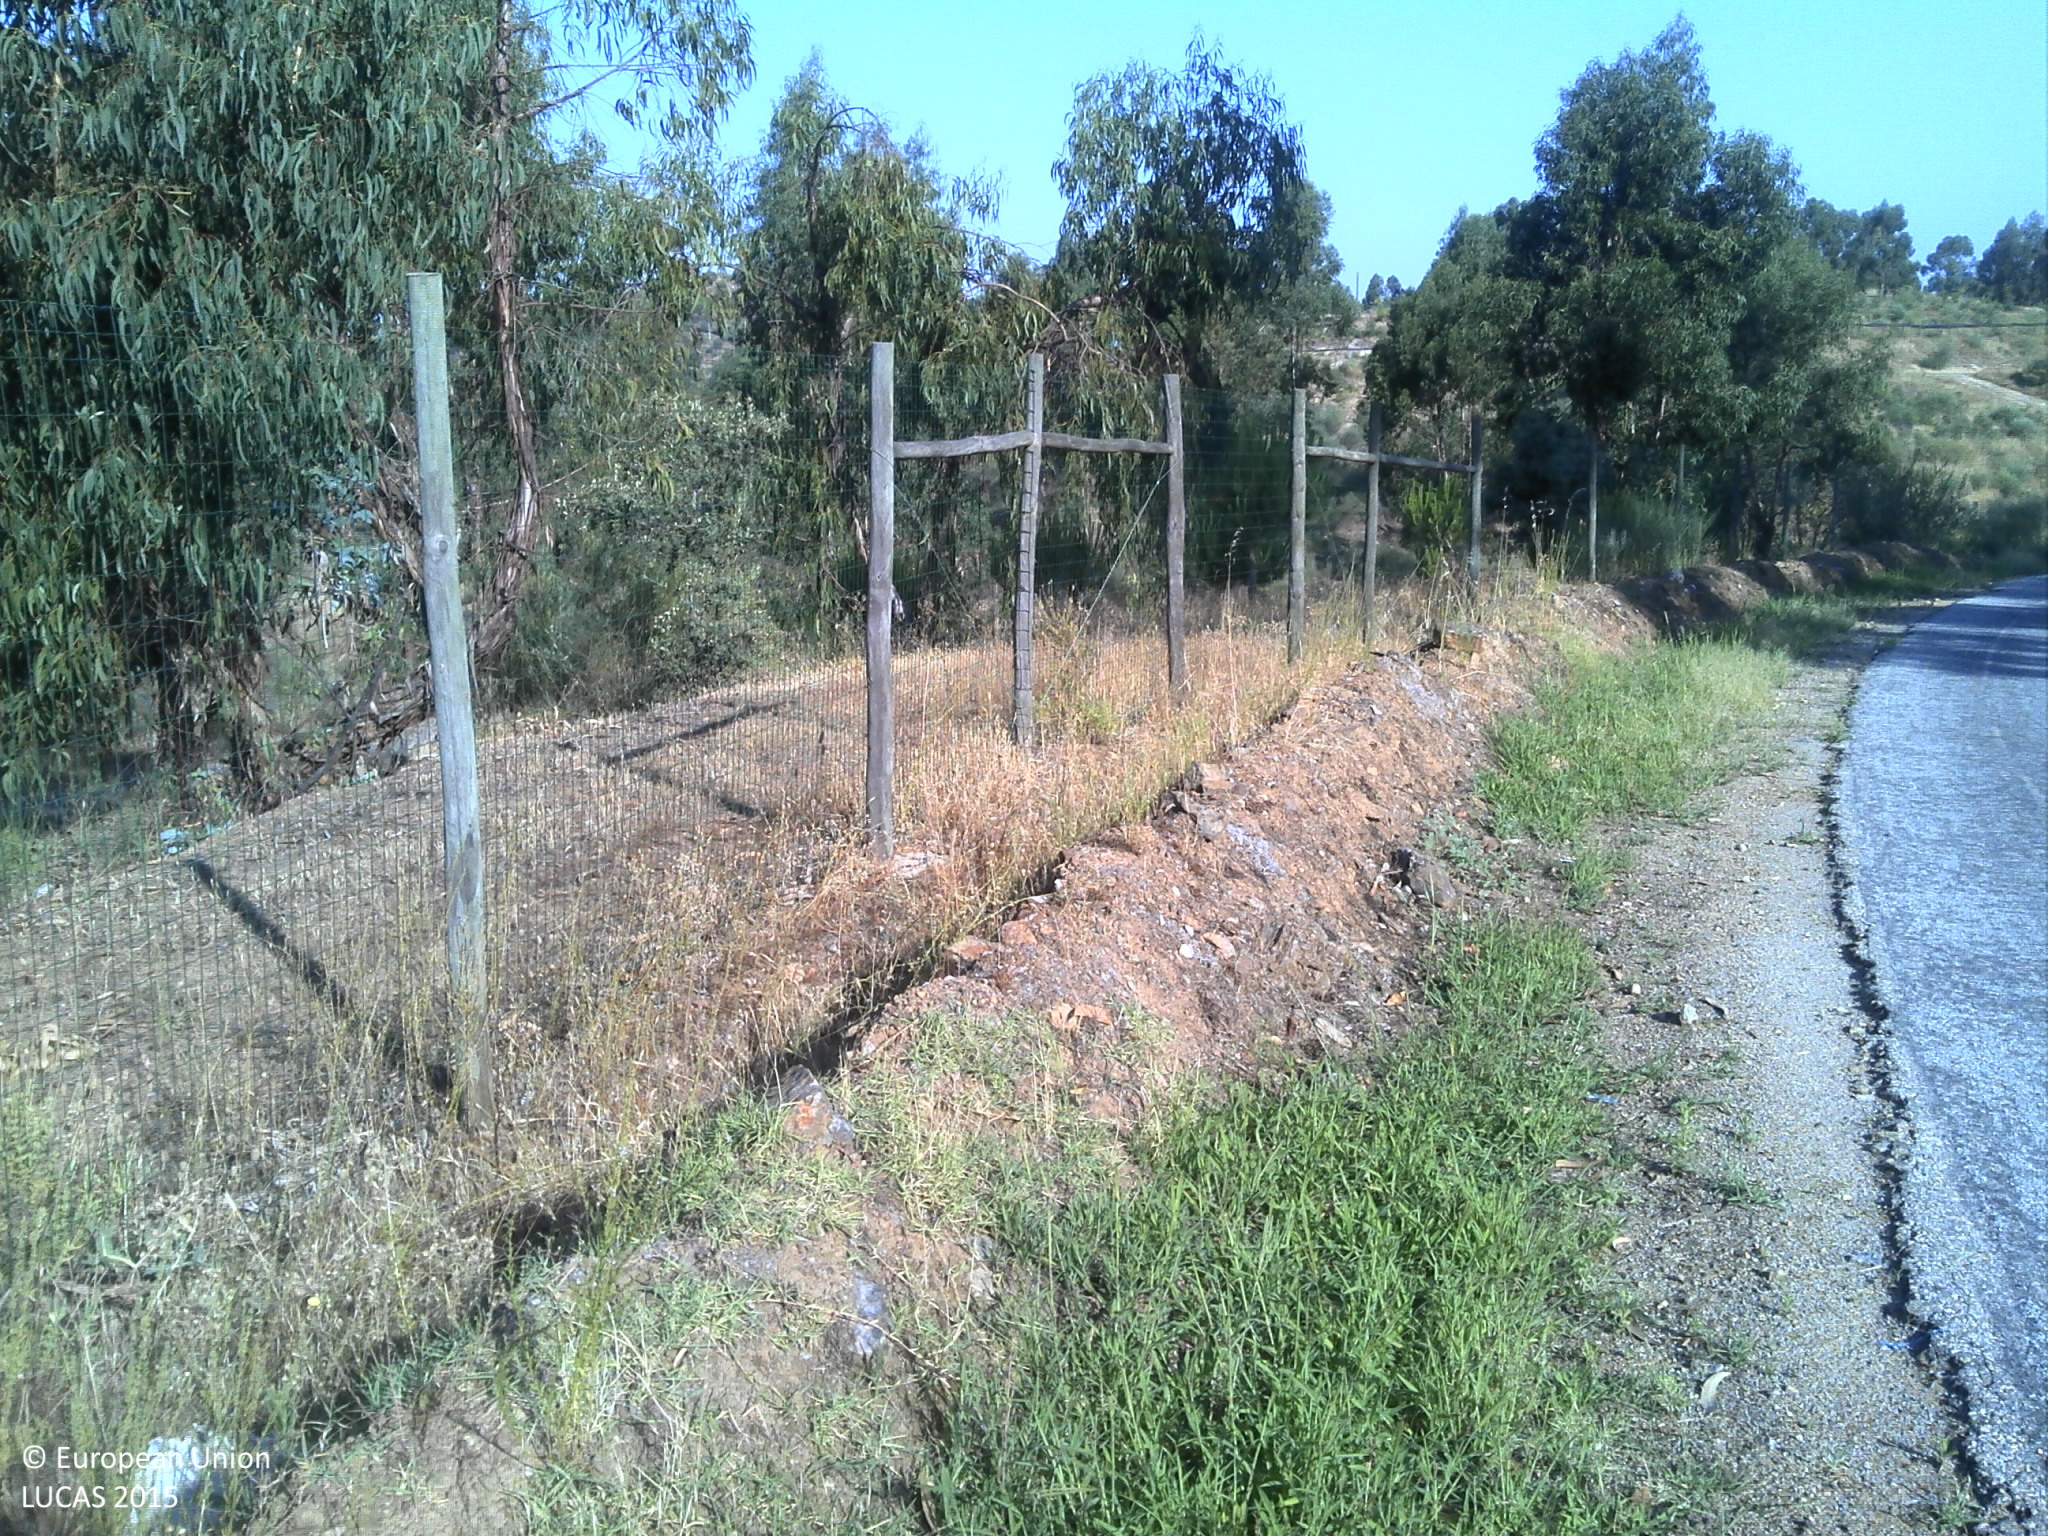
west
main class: Woodland
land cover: Broadleaved woodland
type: broadleaved evergreen forest
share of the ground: 50 - 75 %
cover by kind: broadleaved forest trees 50 %, herbaceous plants 40 %, unconsolidated bare surface 10 %
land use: Forestry
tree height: > 5 m
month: June
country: PT
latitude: 39.9185
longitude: -7.1862
